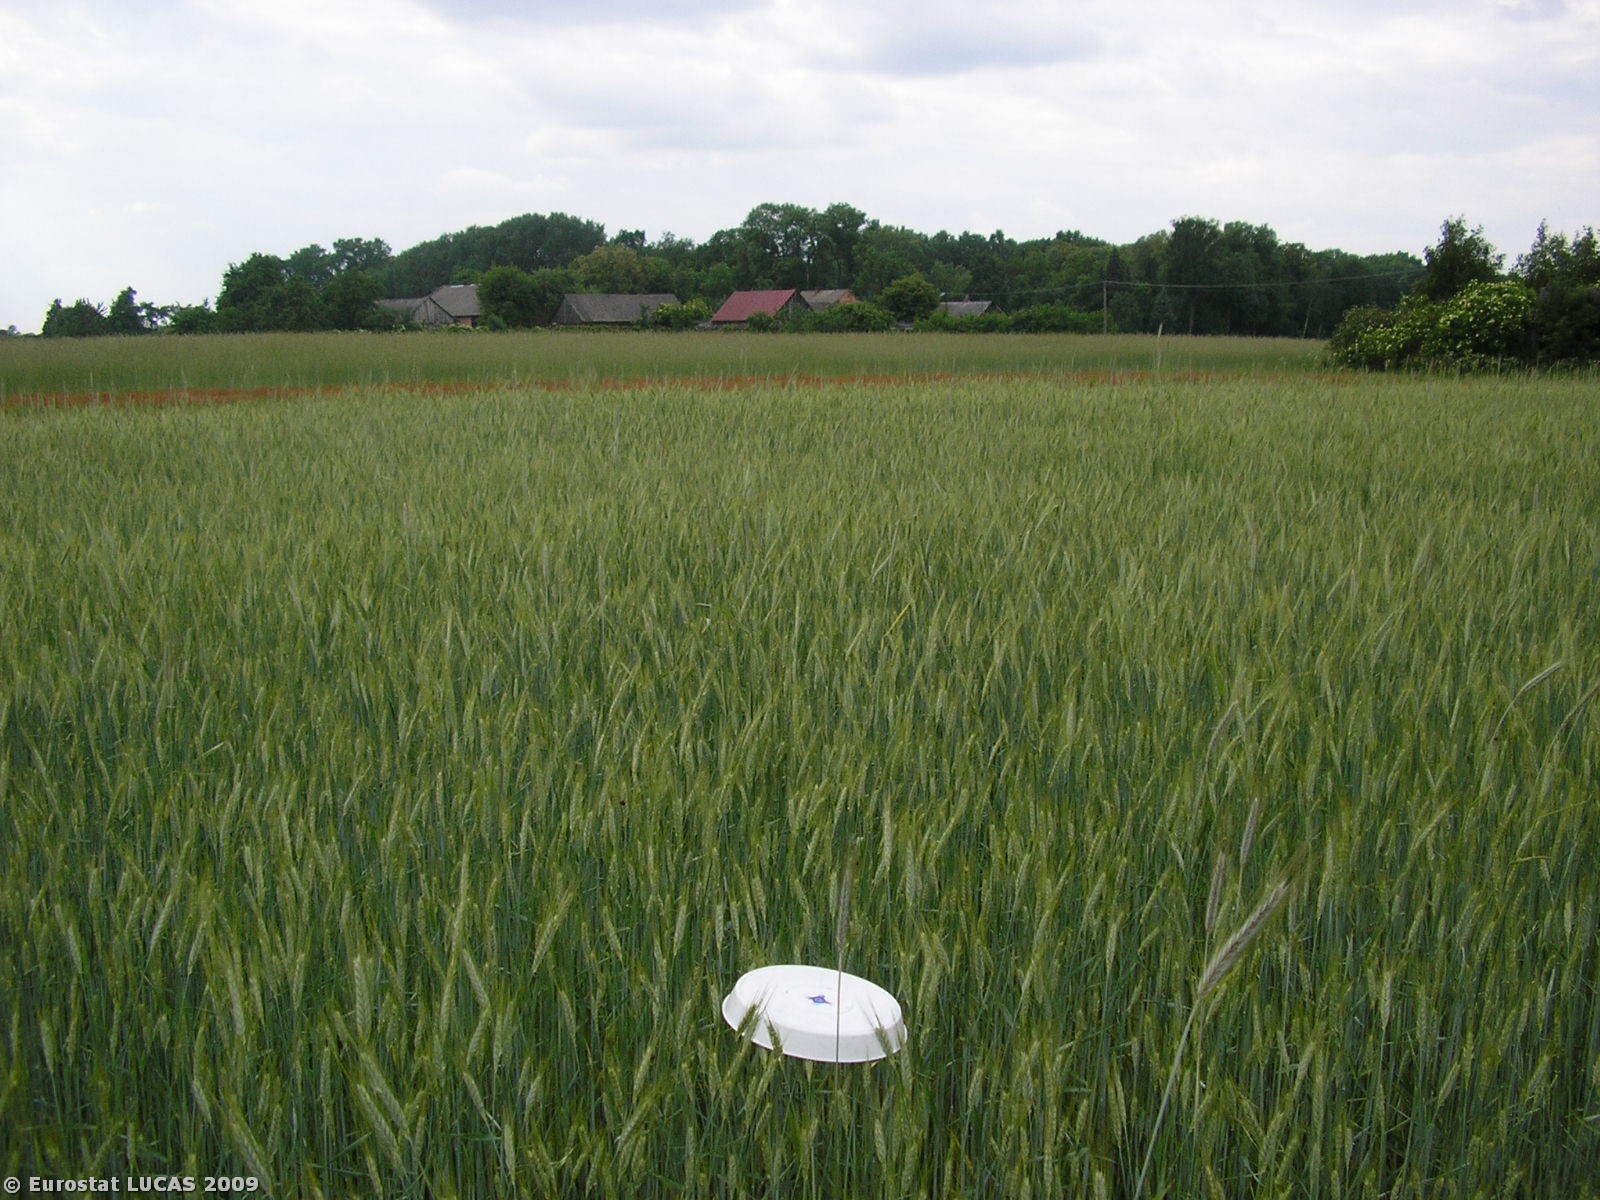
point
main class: Cropland
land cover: Triticale
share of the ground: 50 - 75 %
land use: Agriculture (excluding fallow land and kitchen gardens)
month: June
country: PL
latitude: 51.2342
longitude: 18.3394
